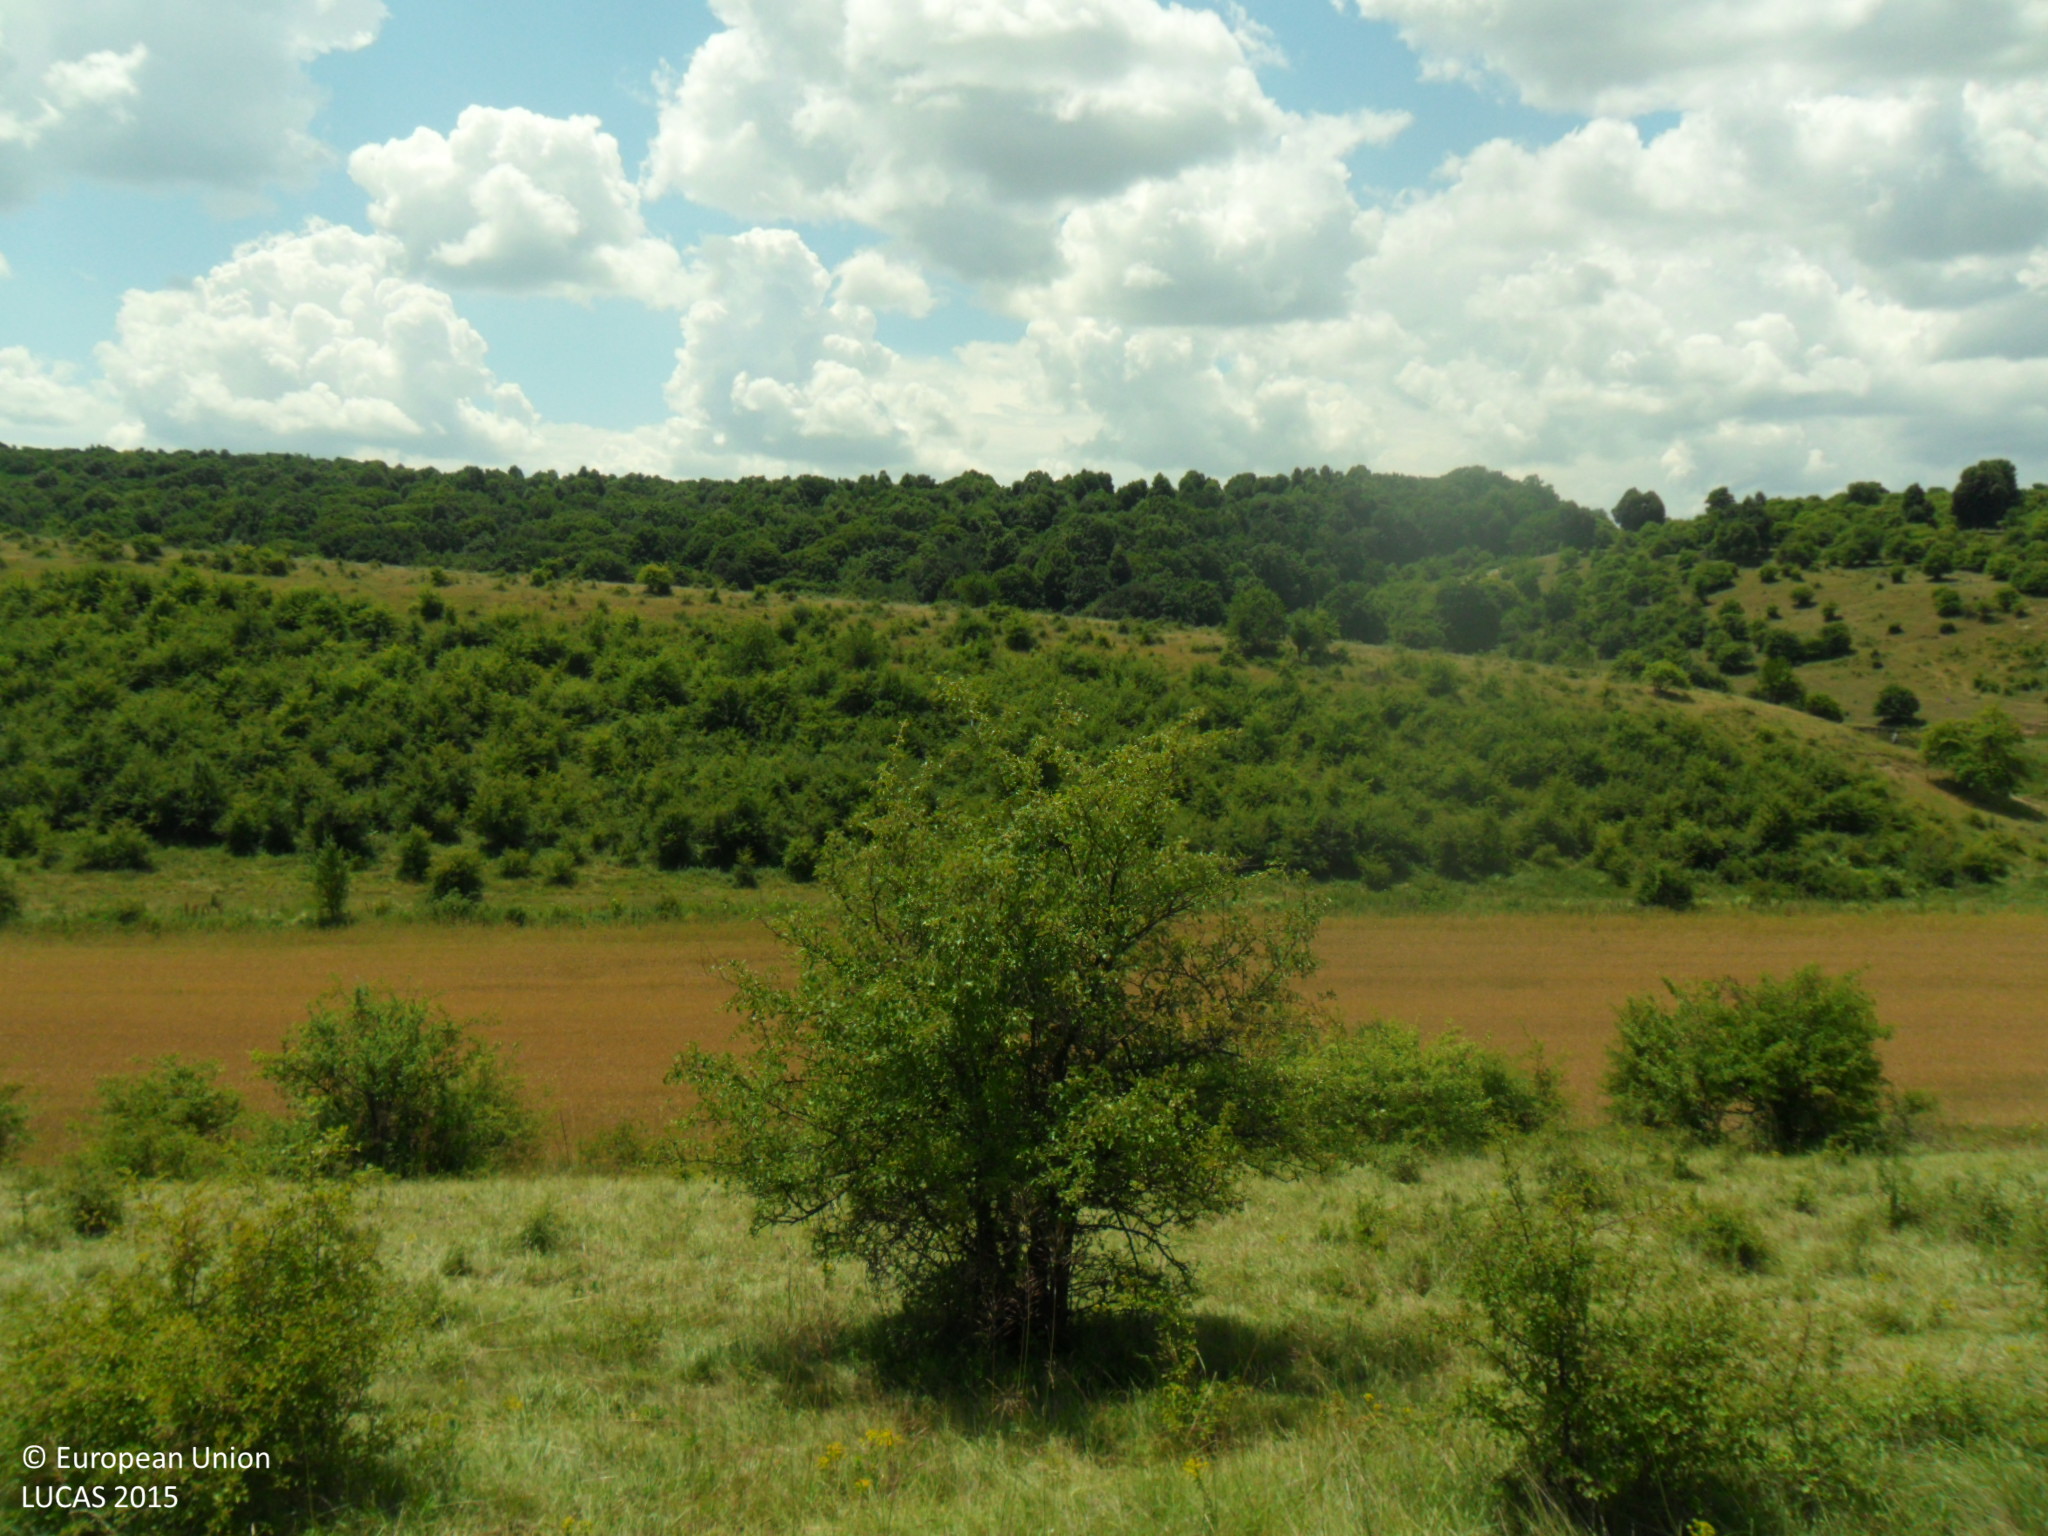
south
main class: Grassland
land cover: Grassland with sparse tree/shrub cover
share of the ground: > 75 %
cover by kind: herbaceous plants 85 %, shrubs 10 %, broadleaved forest trees 5 %
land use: Agriculture (excluding fallow land and kitchen gardens)
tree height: < 5 m
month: June
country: BG
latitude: 43.4152
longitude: 26.7709
